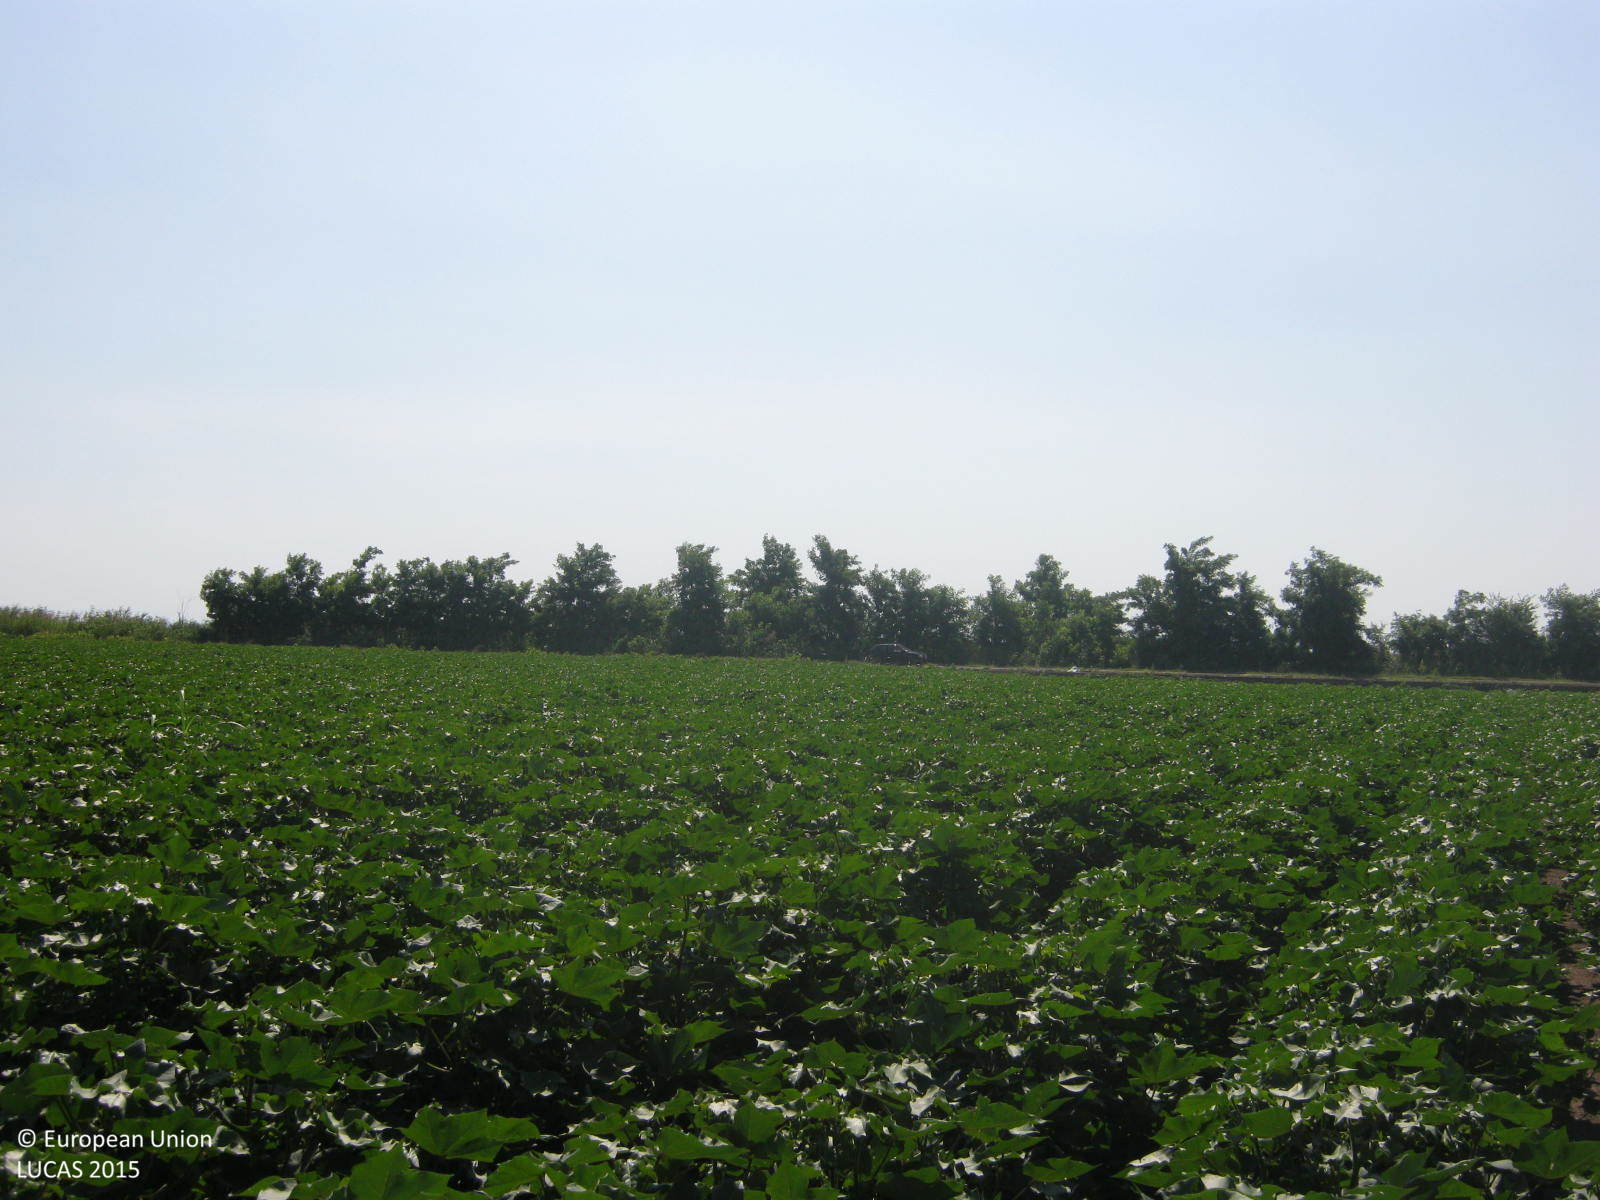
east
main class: Cropland
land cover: Cotton
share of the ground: > 75 %
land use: Agriculture (excluding fallow land and kitchen gardens)
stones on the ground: < 10 %
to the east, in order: Cotton; Grass margins; Cotton; Shruby margins; Tracks; Shruby margins; Abandoned hedges; Ditches and canals; Broadleaved woodland; Rice
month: July
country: GR
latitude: 40.6850
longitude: 22.5336
